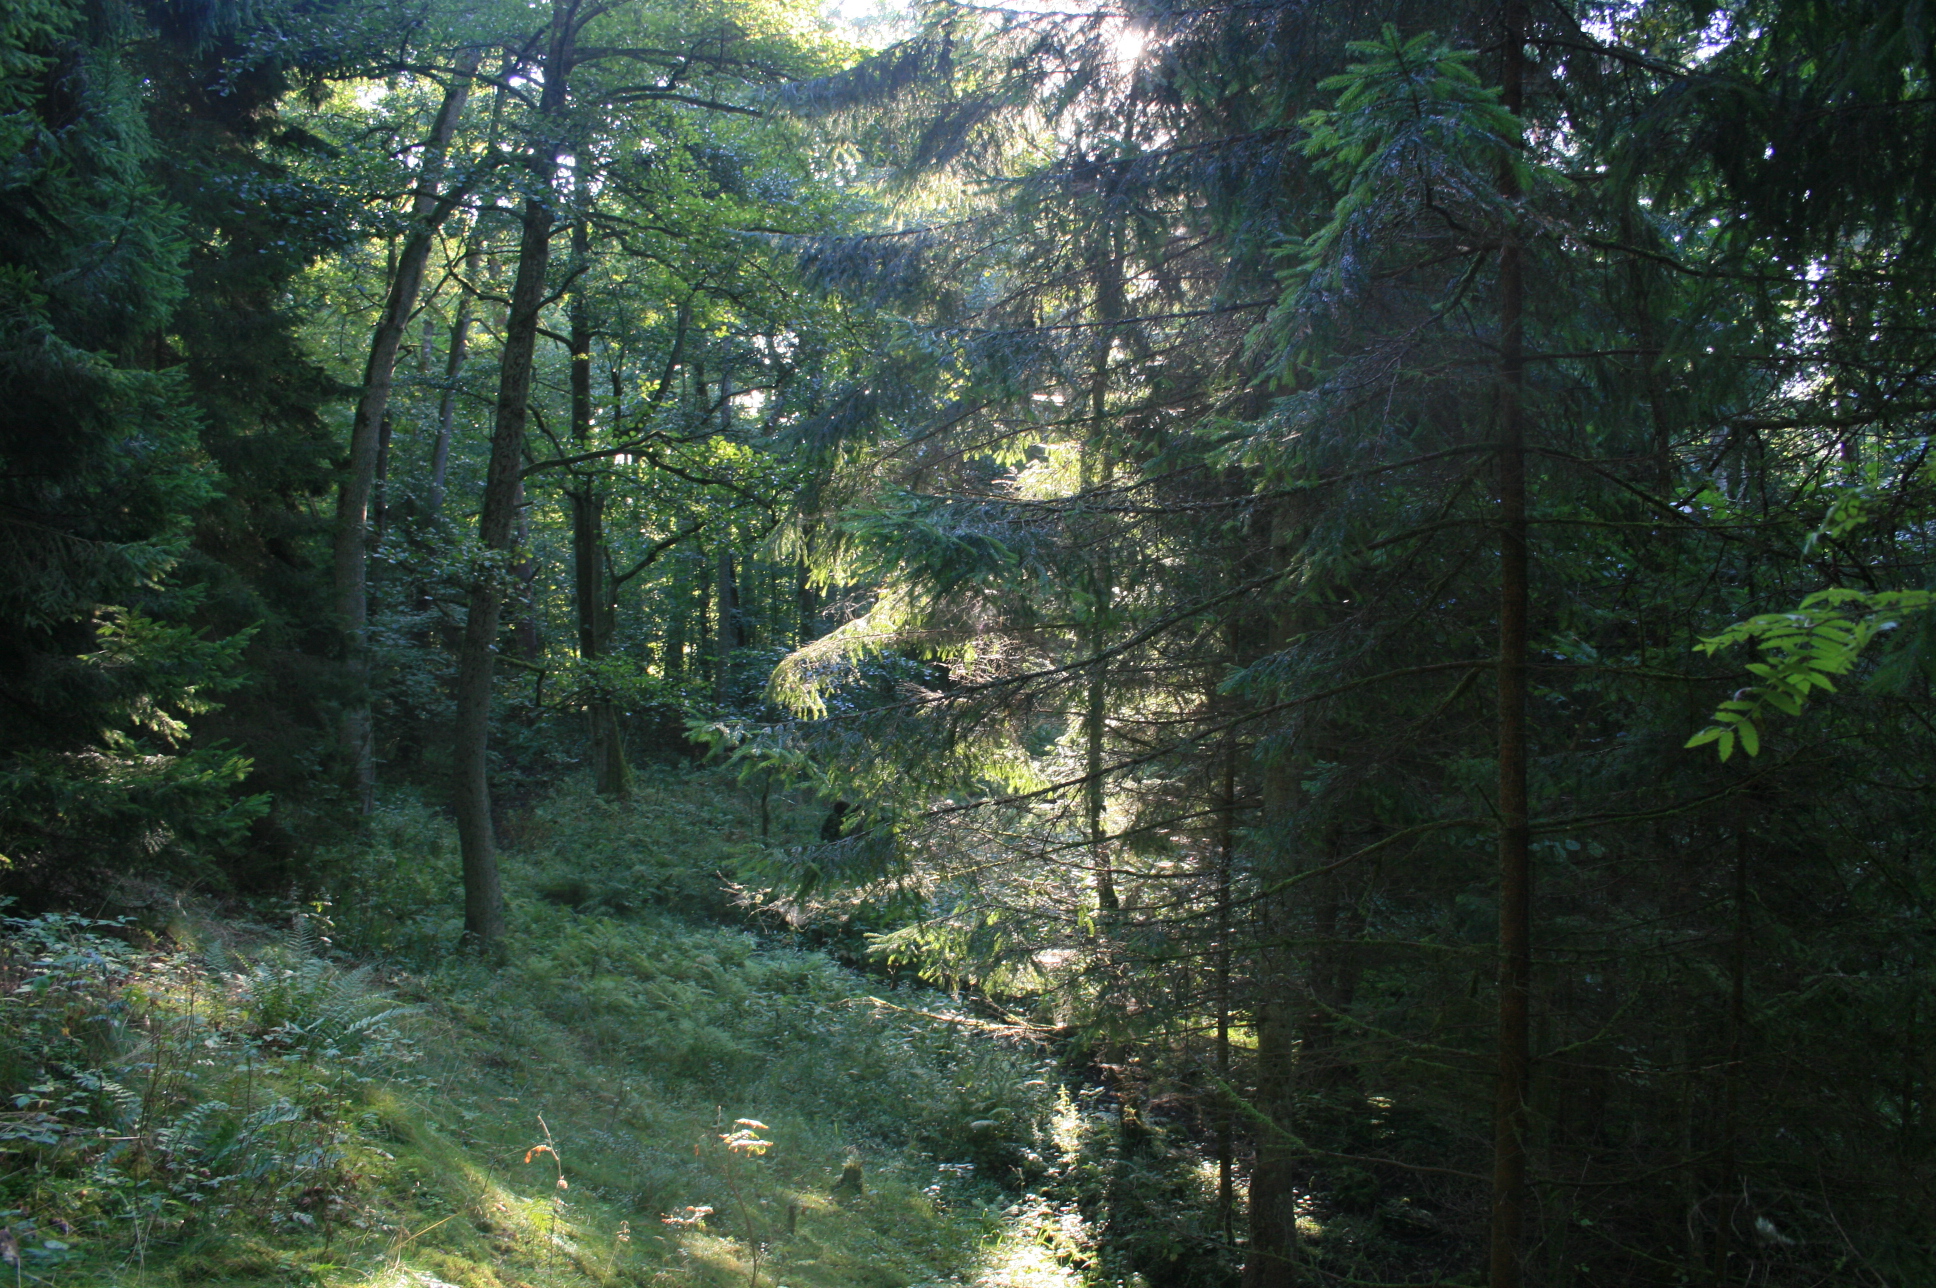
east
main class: Woodland
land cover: Other mixed woodland
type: hemiboreal forest and nemoral coniferous forest and mixed broadleaved-coniferous forest
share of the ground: > 75 %
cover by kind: coniferous forest trees 55 %, broadleaved forest trees 25 %, herbaceous plants 10 %, lichens and mosses 10 %
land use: Forestry
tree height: > 5 m
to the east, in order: Other mixed woodland; Broadleaved woodland; Inland fresh water bodies; Broadleaved woodland; Paved roads, cycling and walking lanes
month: September
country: LT
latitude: 55.5573
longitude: 21.1223
